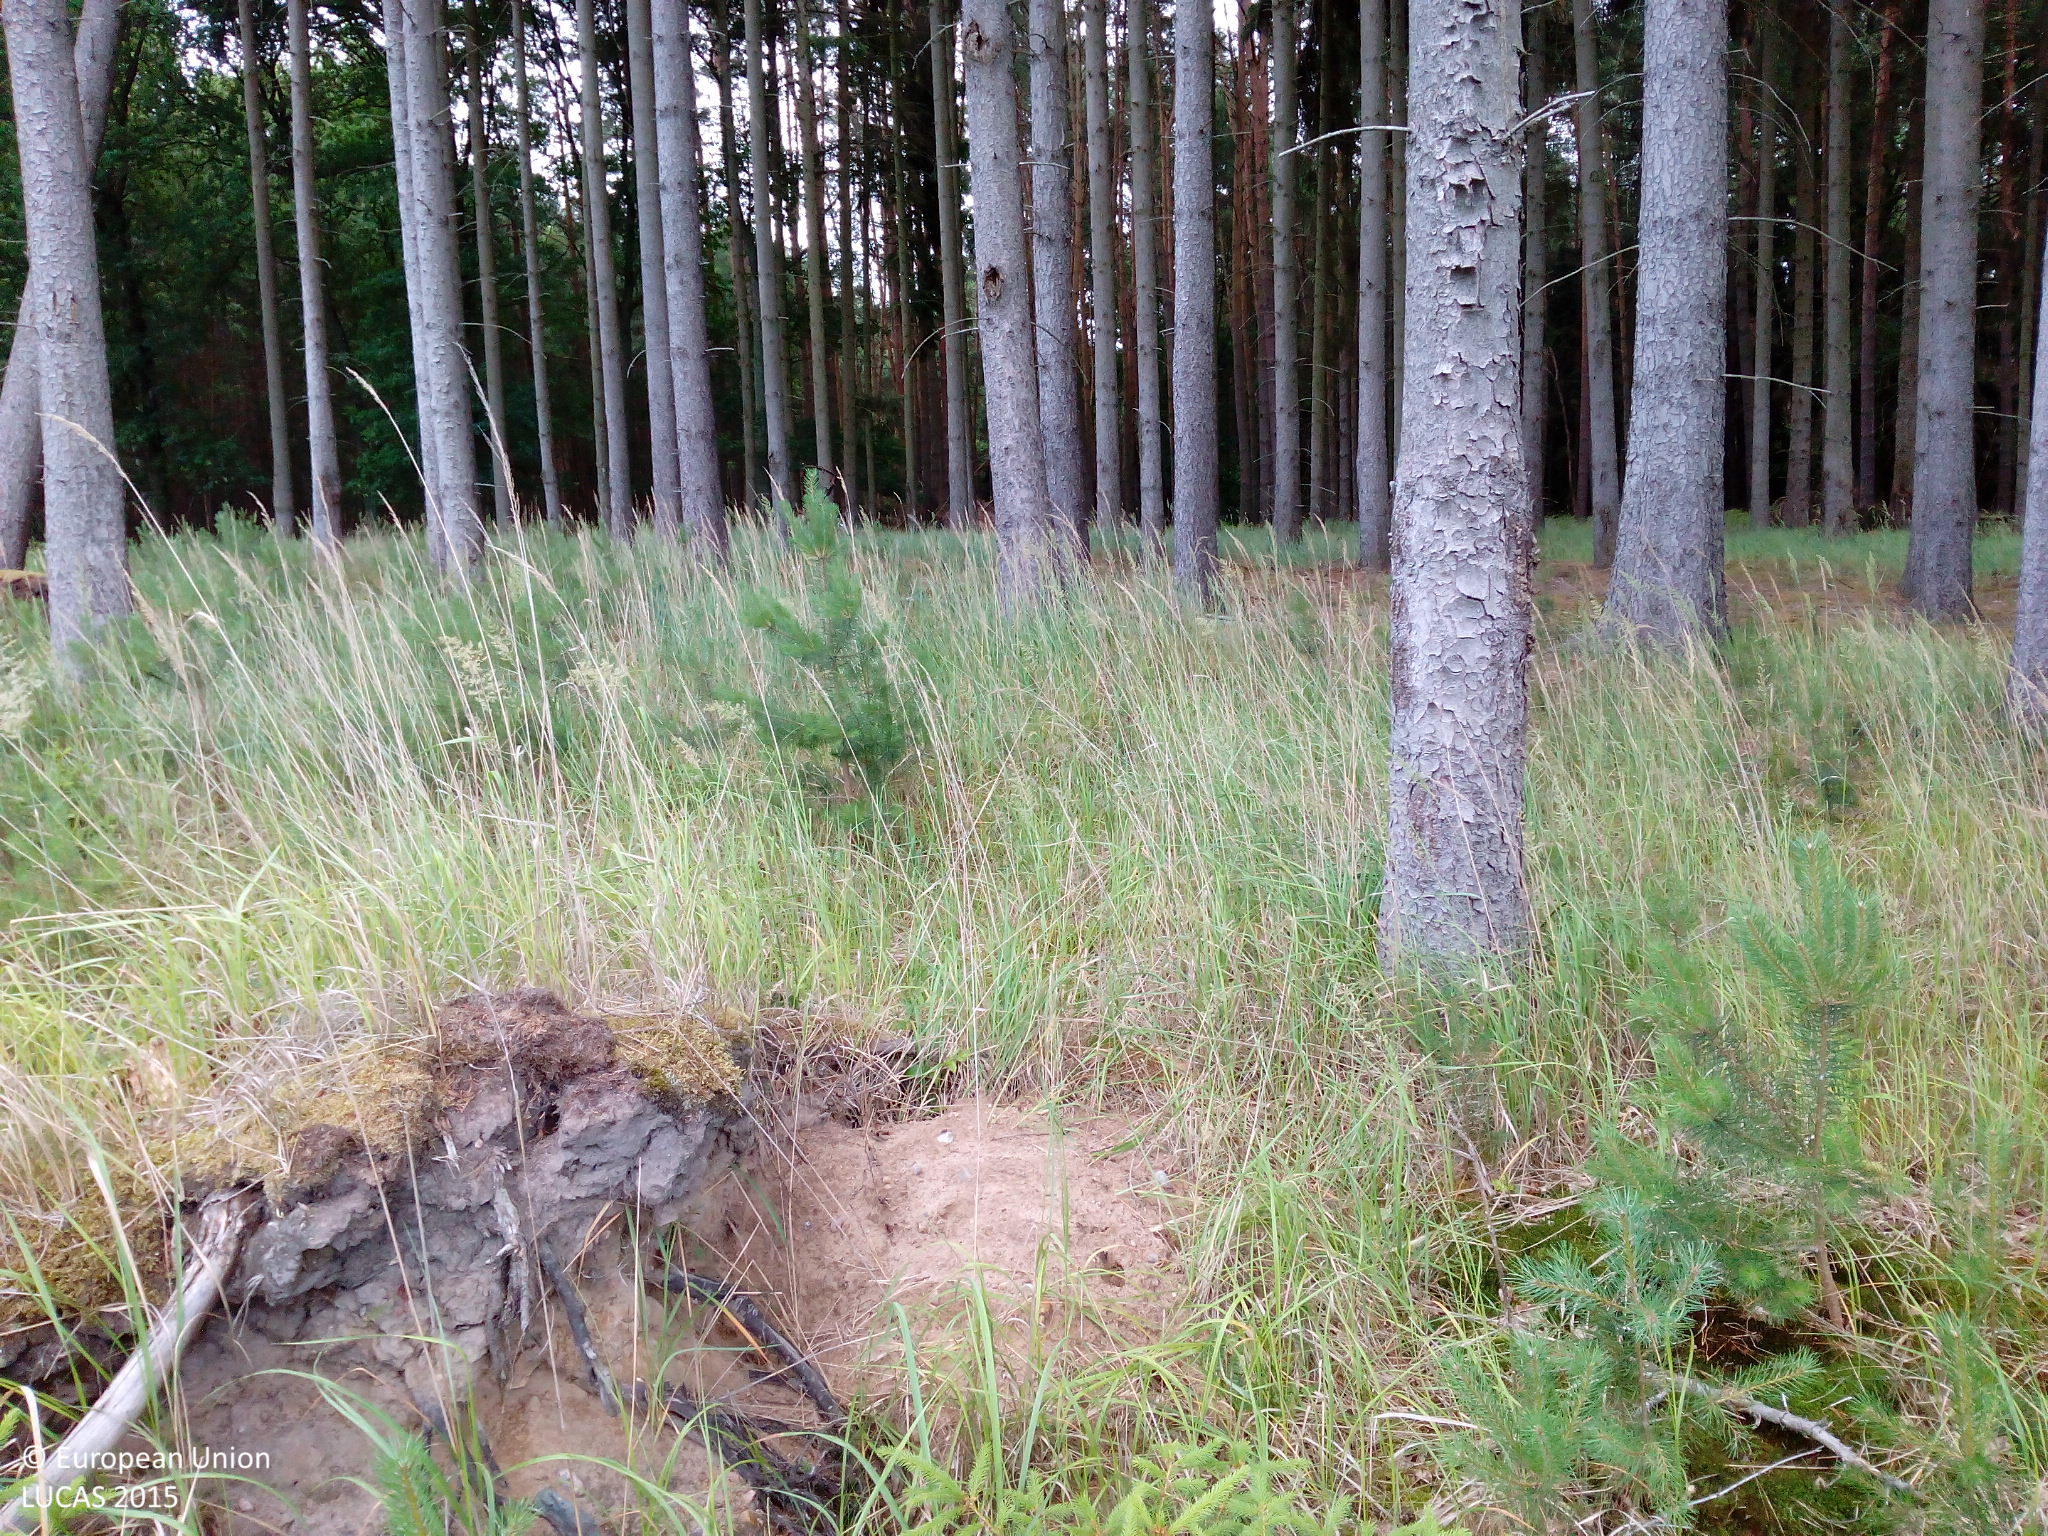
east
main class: Woodland
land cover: Broadleaved woodland
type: mesophytic deciduous forest
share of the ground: 50 - 75 %
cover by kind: broadleaved forest trees 50 %, shrubs 25 %, herbaceous plants 20 %, coniferous forest trees 5 %
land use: Forestry
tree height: < 5 m
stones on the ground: < 10 %
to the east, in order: Broadleaved woodland; Fences; Spruce dominated coniferous woodland; Pine dominated coniferous woodland; Tracks; Pine dominated coniferous woodland
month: July
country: DE
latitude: 52.8804
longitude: 13.6110
